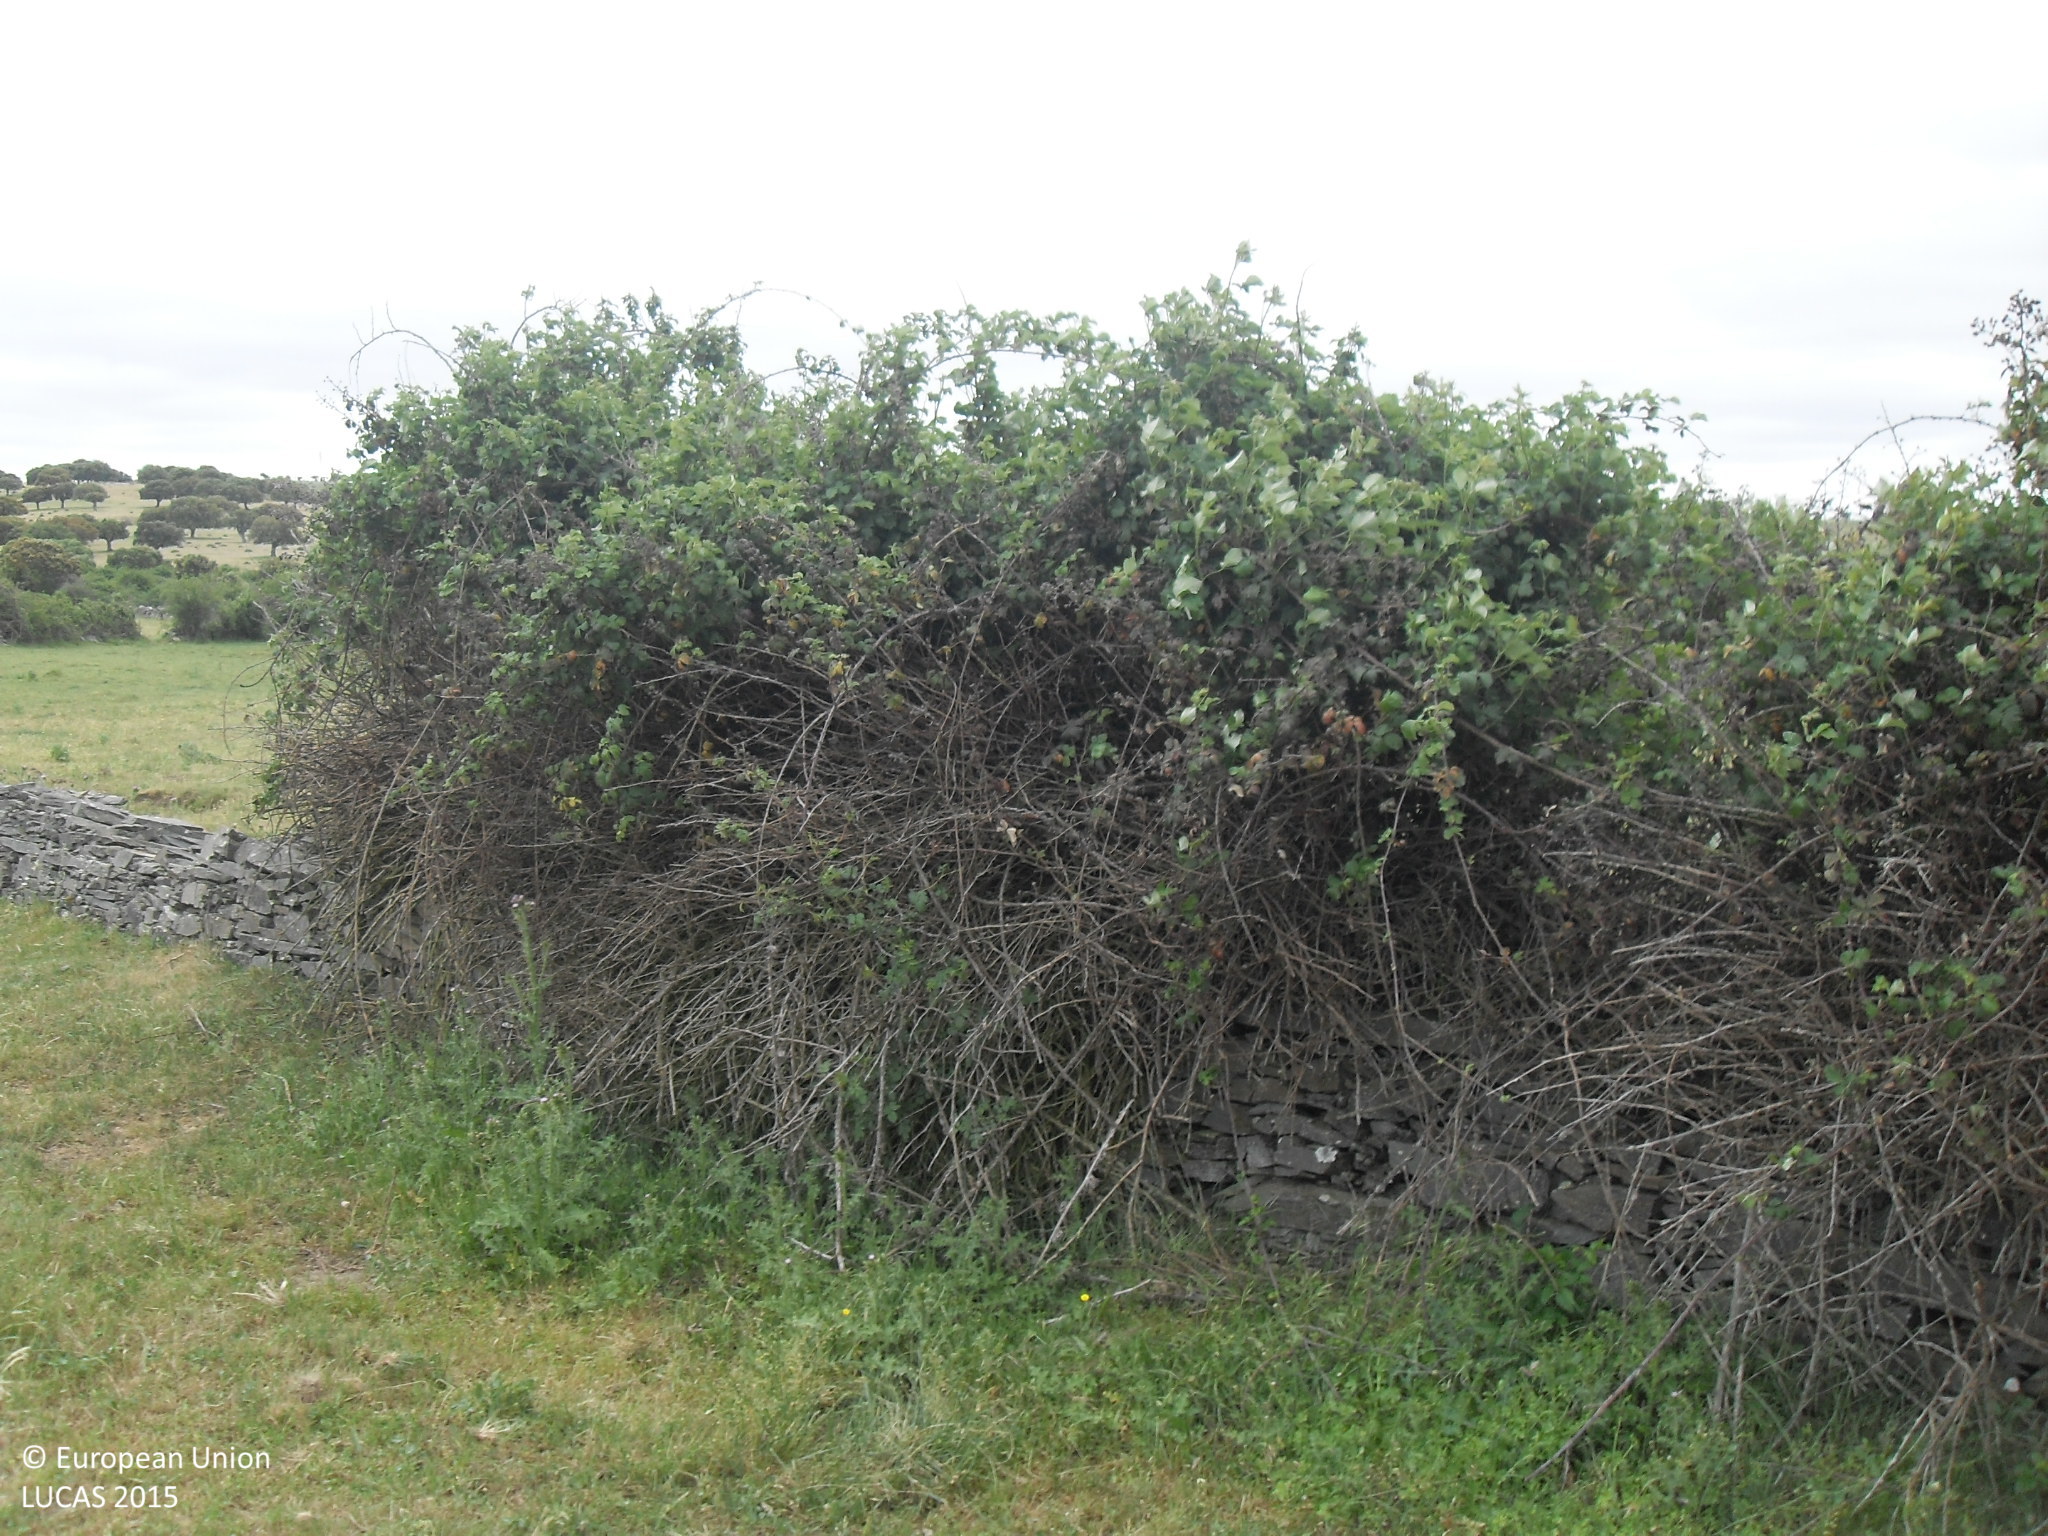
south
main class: Grassland
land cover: Grassland without tree/shrub cover
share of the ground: > 75 %
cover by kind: herbaceous plants 100 %
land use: Agriculture (excluding fallow land and kitchen gardens)
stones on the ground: 10 - 25 %
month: May
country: ES
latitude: 40.6397
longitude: -5.6448
